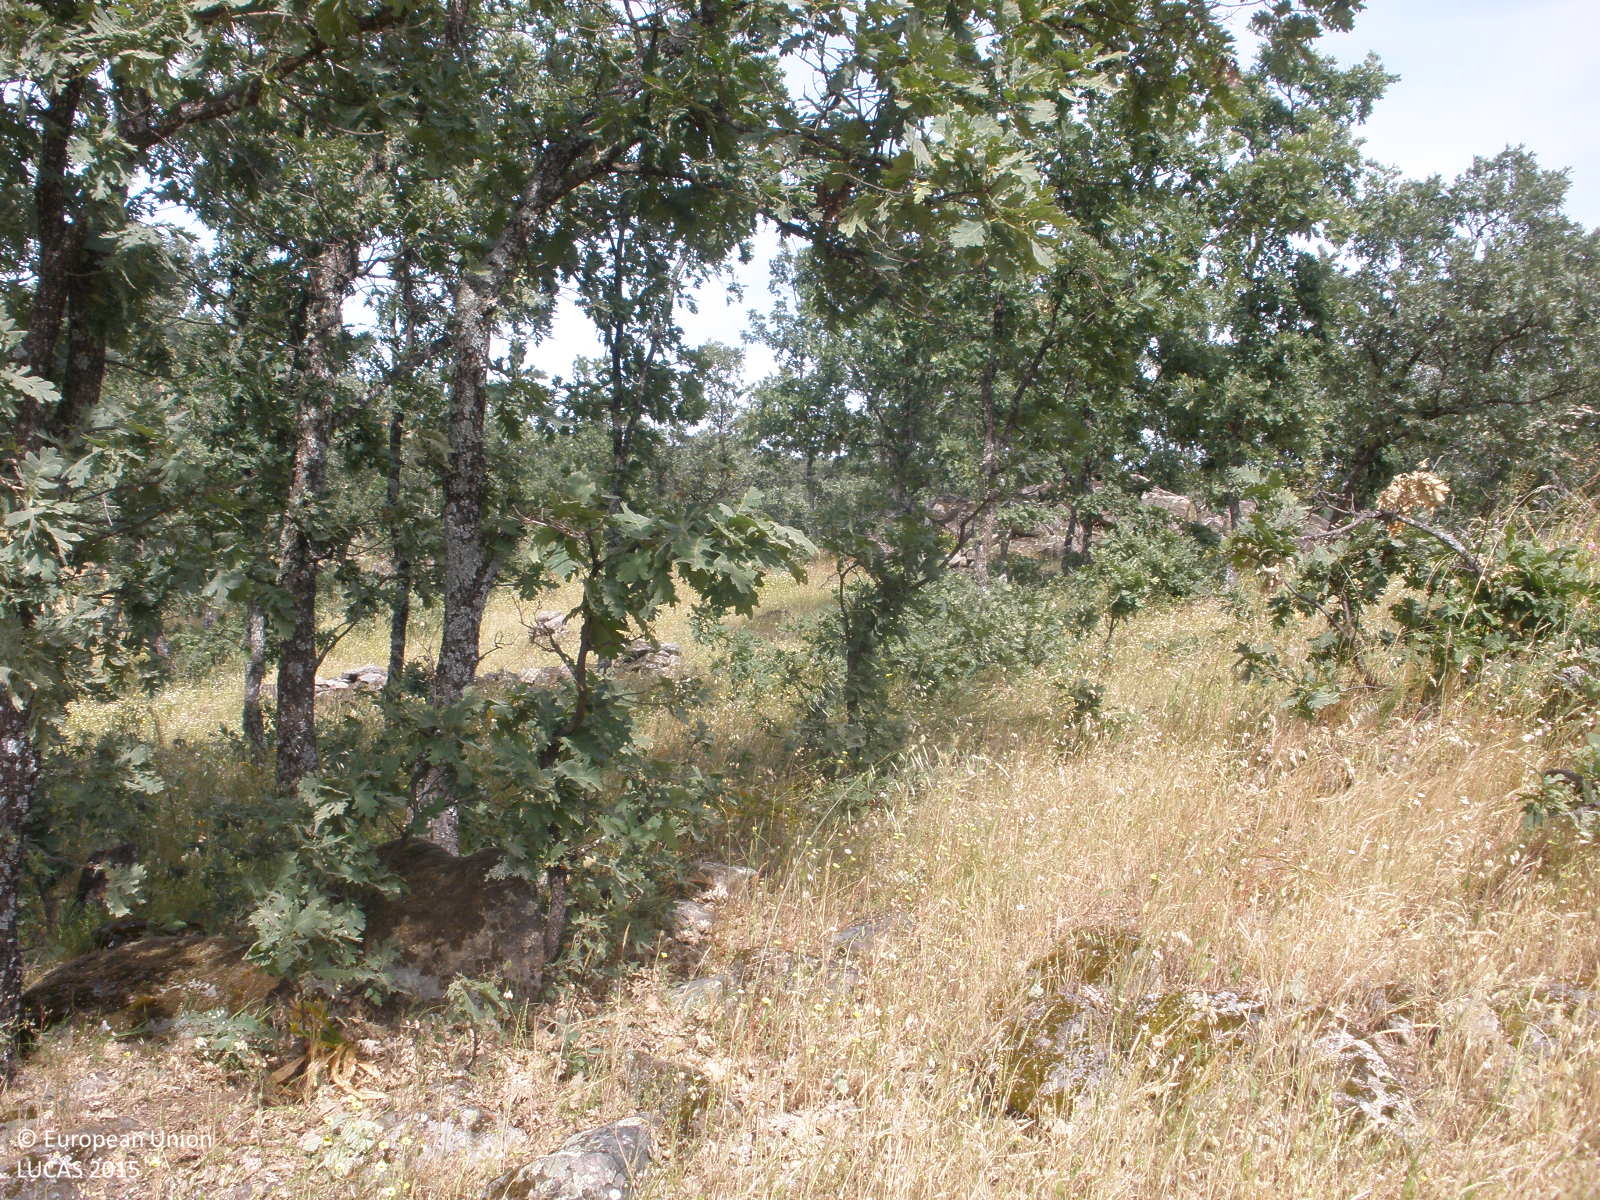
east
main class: Woodland
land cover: Broadleaved woodland
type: thermophilous deciduous forest
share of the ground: 50 - 75 %
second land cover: Grassland without tree/shrub cover
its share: > 75 %
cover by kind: herbaceous plants 50 %, broadleaved forest trees 40 %, consolidated bare surface 10 %
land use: Forestry
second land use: Agriculture (excluding fallow land and kitchen gardens)
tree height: > 5 m
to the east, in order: Broadleaved woodland; Grassland without tree/shrub cover; Rock outcrops; Broadleaved woodland; Dry stone walls; Broadleaved woodland; Dry stone walls; Broadleaved woodland; Grassland without tree/shrub cover
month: May
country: ES
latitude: 40.1715
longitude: -6.5825
